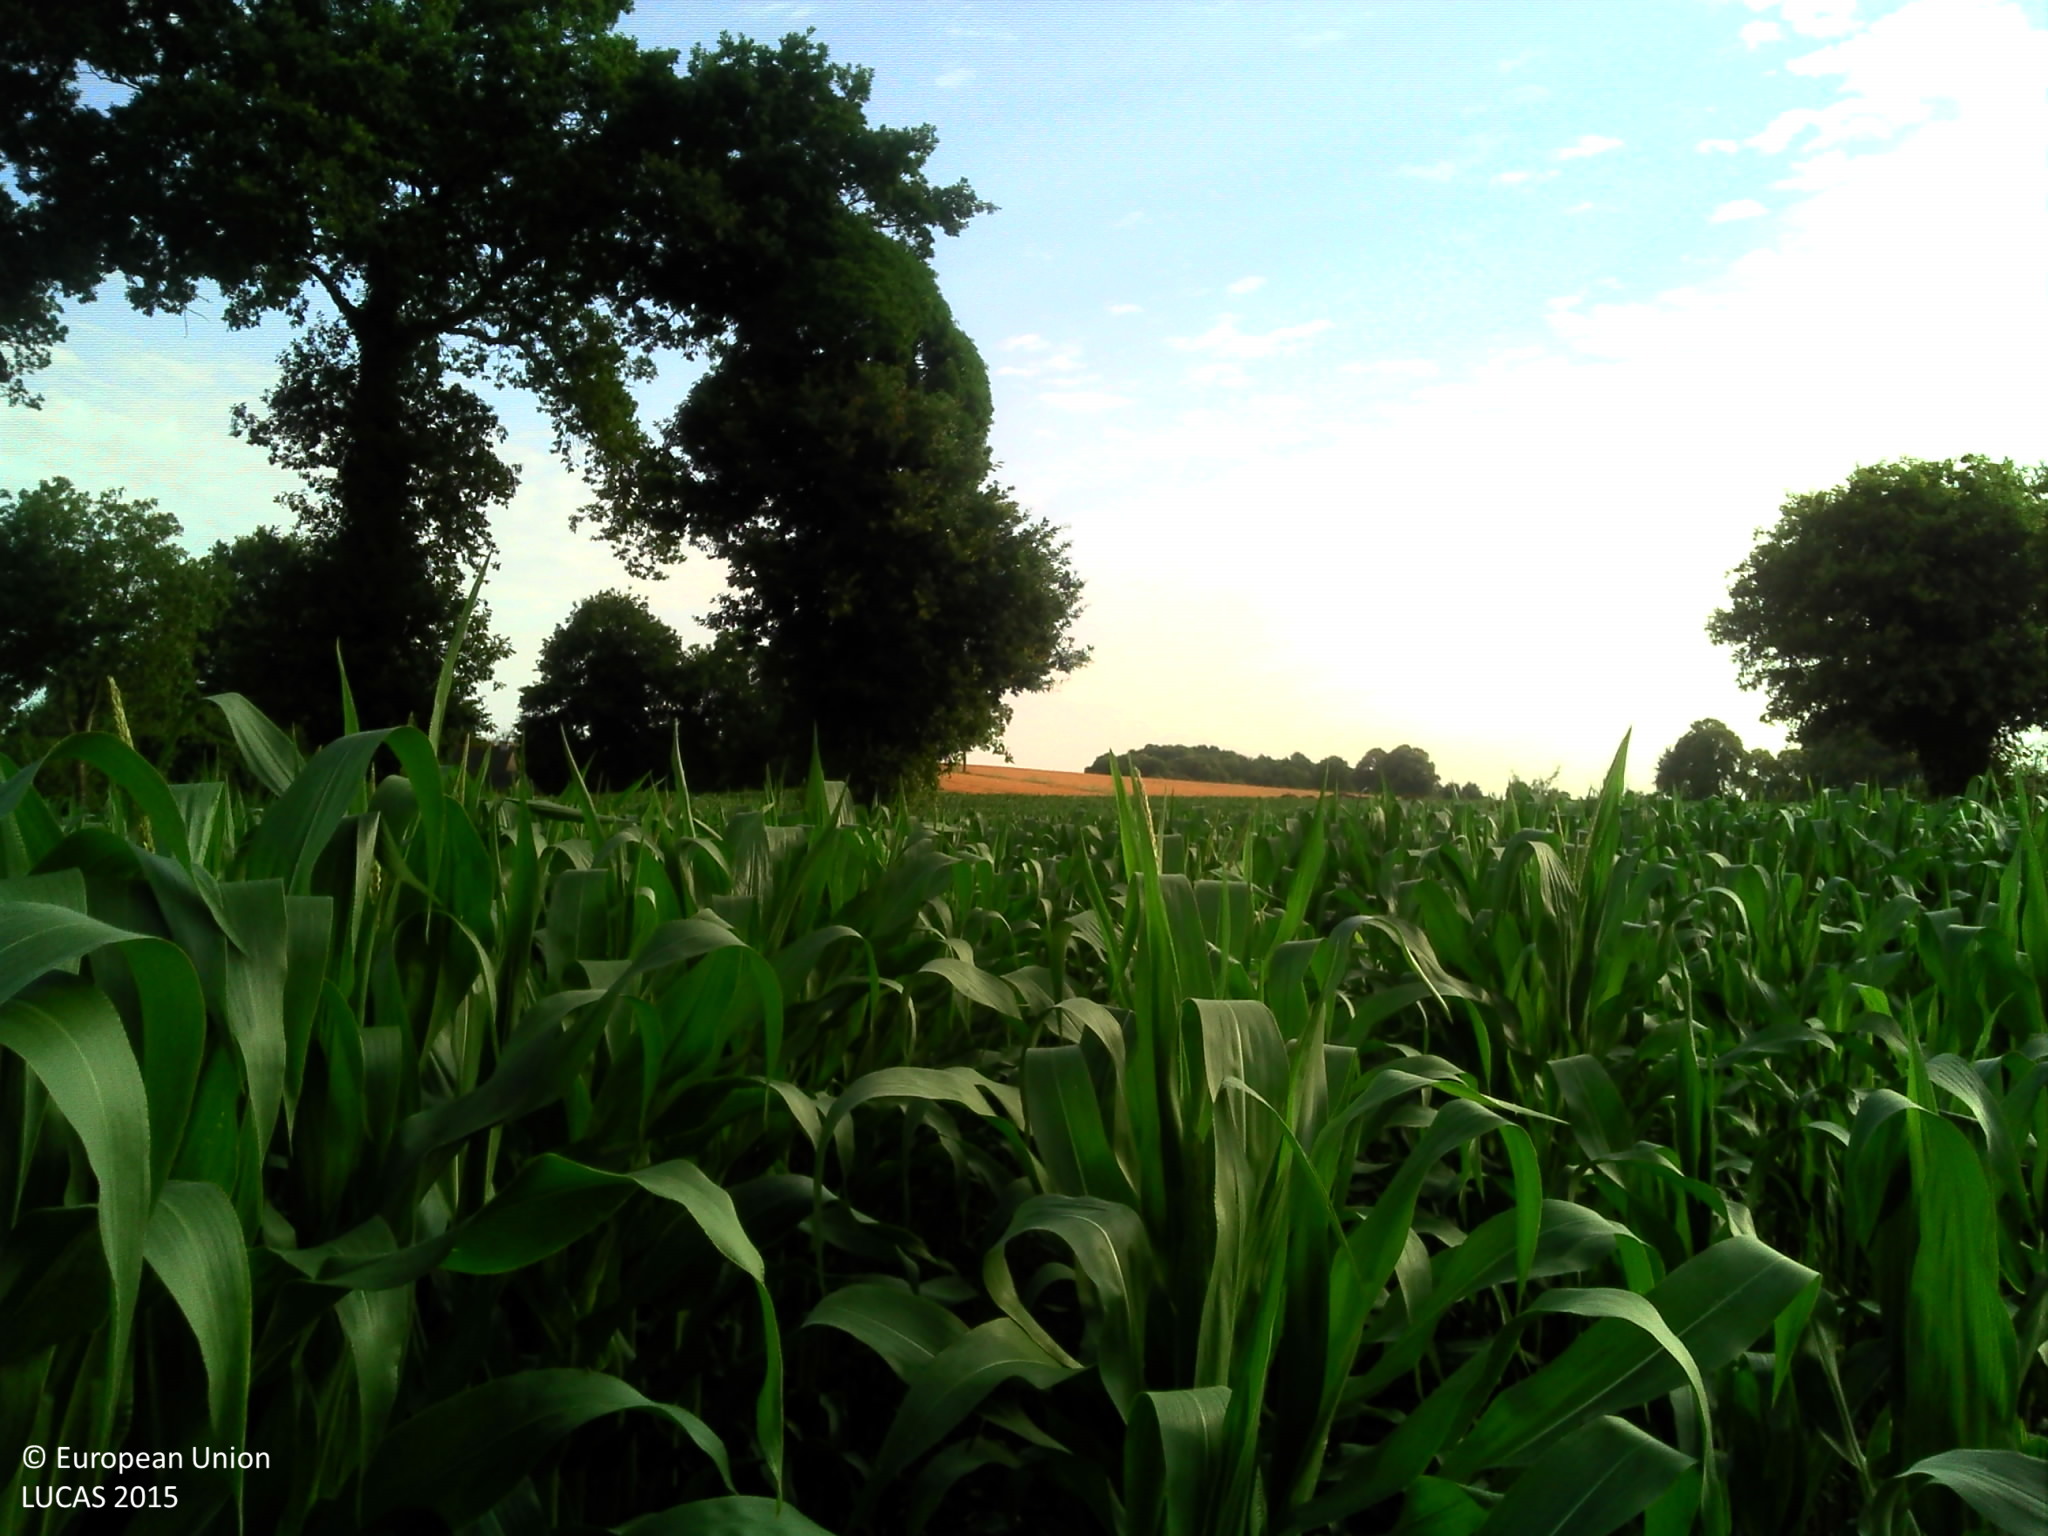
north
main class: Cropland
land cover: Maize
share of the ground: > 75 %
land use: Agriculture (excluding fallow land and kitchen gardens)
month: July
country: FR
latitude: 48.3620
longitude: -1.6972
